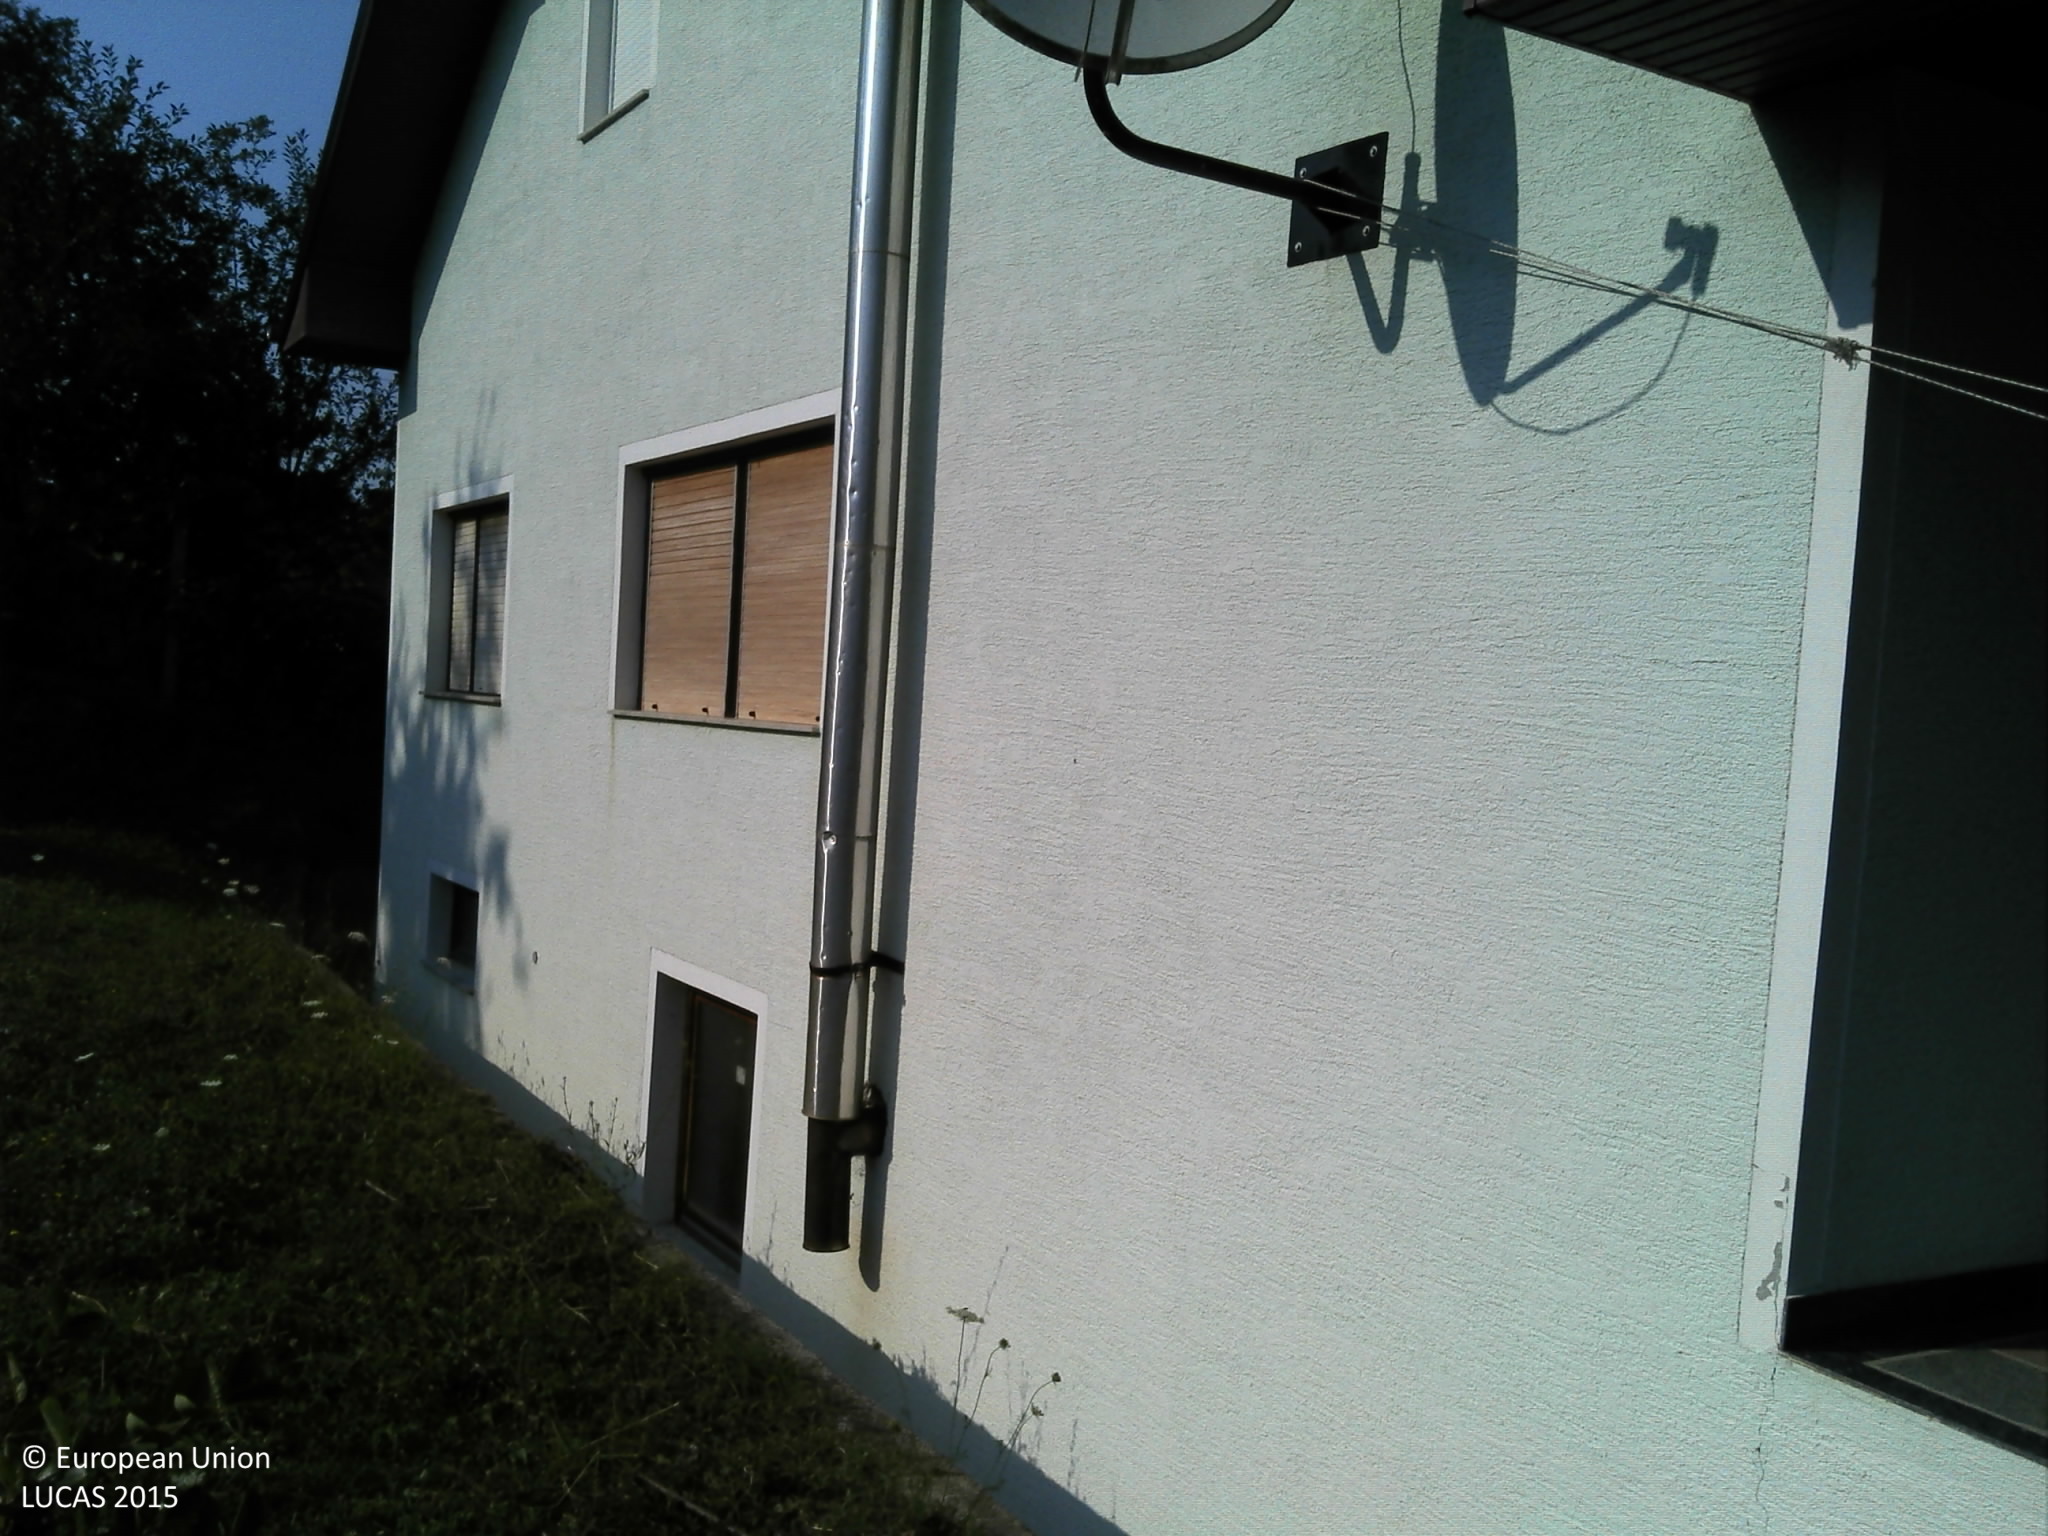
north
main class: Grassland
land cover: Spontaneously vegetated surfaces
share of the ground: > 75 %
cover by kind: herbaceous plants 100 %
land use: Fallow land
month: August
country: HR
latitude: 45.5846
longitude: 17.1909
